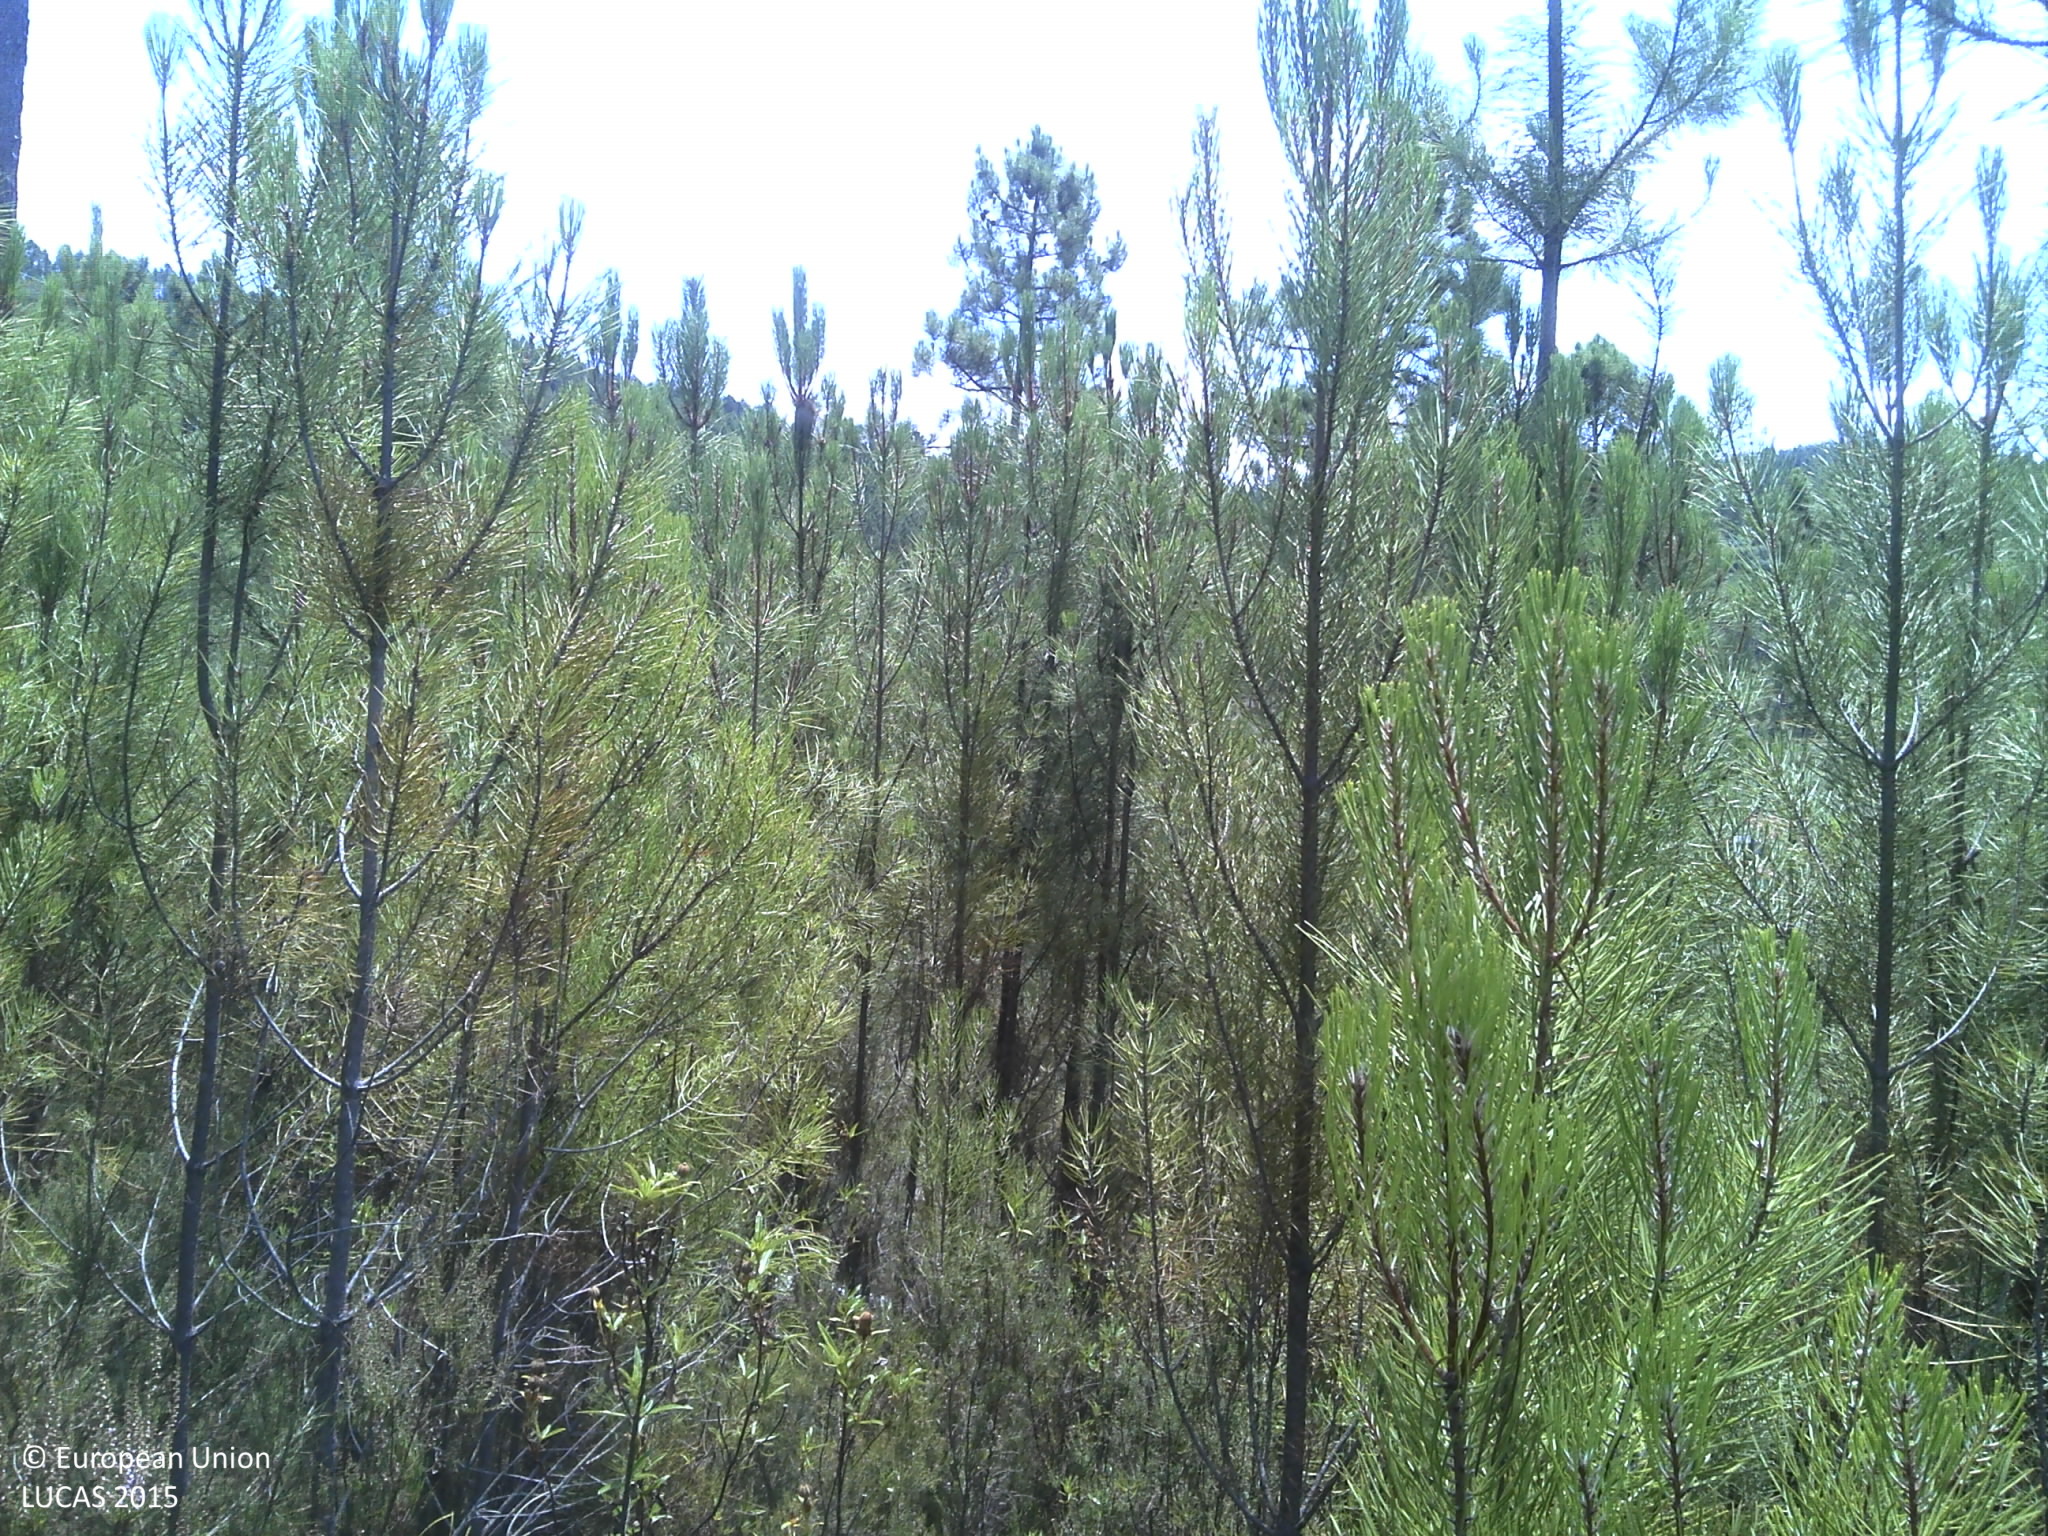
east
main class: Woodland
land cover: Pine dominated coniferous woodland
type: coniferous forest of the mediterranean region
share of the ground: 25 - 50 %
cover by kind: coniferous forest trees 50 %, shrubs 30 %, unconsolidated bare surface 20 %
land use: Forestry
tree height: < 5 m
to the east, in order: Pine dominated coniferous woodland; Electric lines; Pine dominated coniferous woodland; Electric lines; Tracks; Olive groves; Dry stone walls; Rivers and streams; Dry stone walls; Olive groves; Dry stone walls; Olive groves; Dry stone walls; Olive groves; Dry stone walls; Olive groves; Dry stone walls; Tracks; Pine dominated coniferous woodland
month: July
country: PT
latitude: 40.0867
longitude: -7.7853
